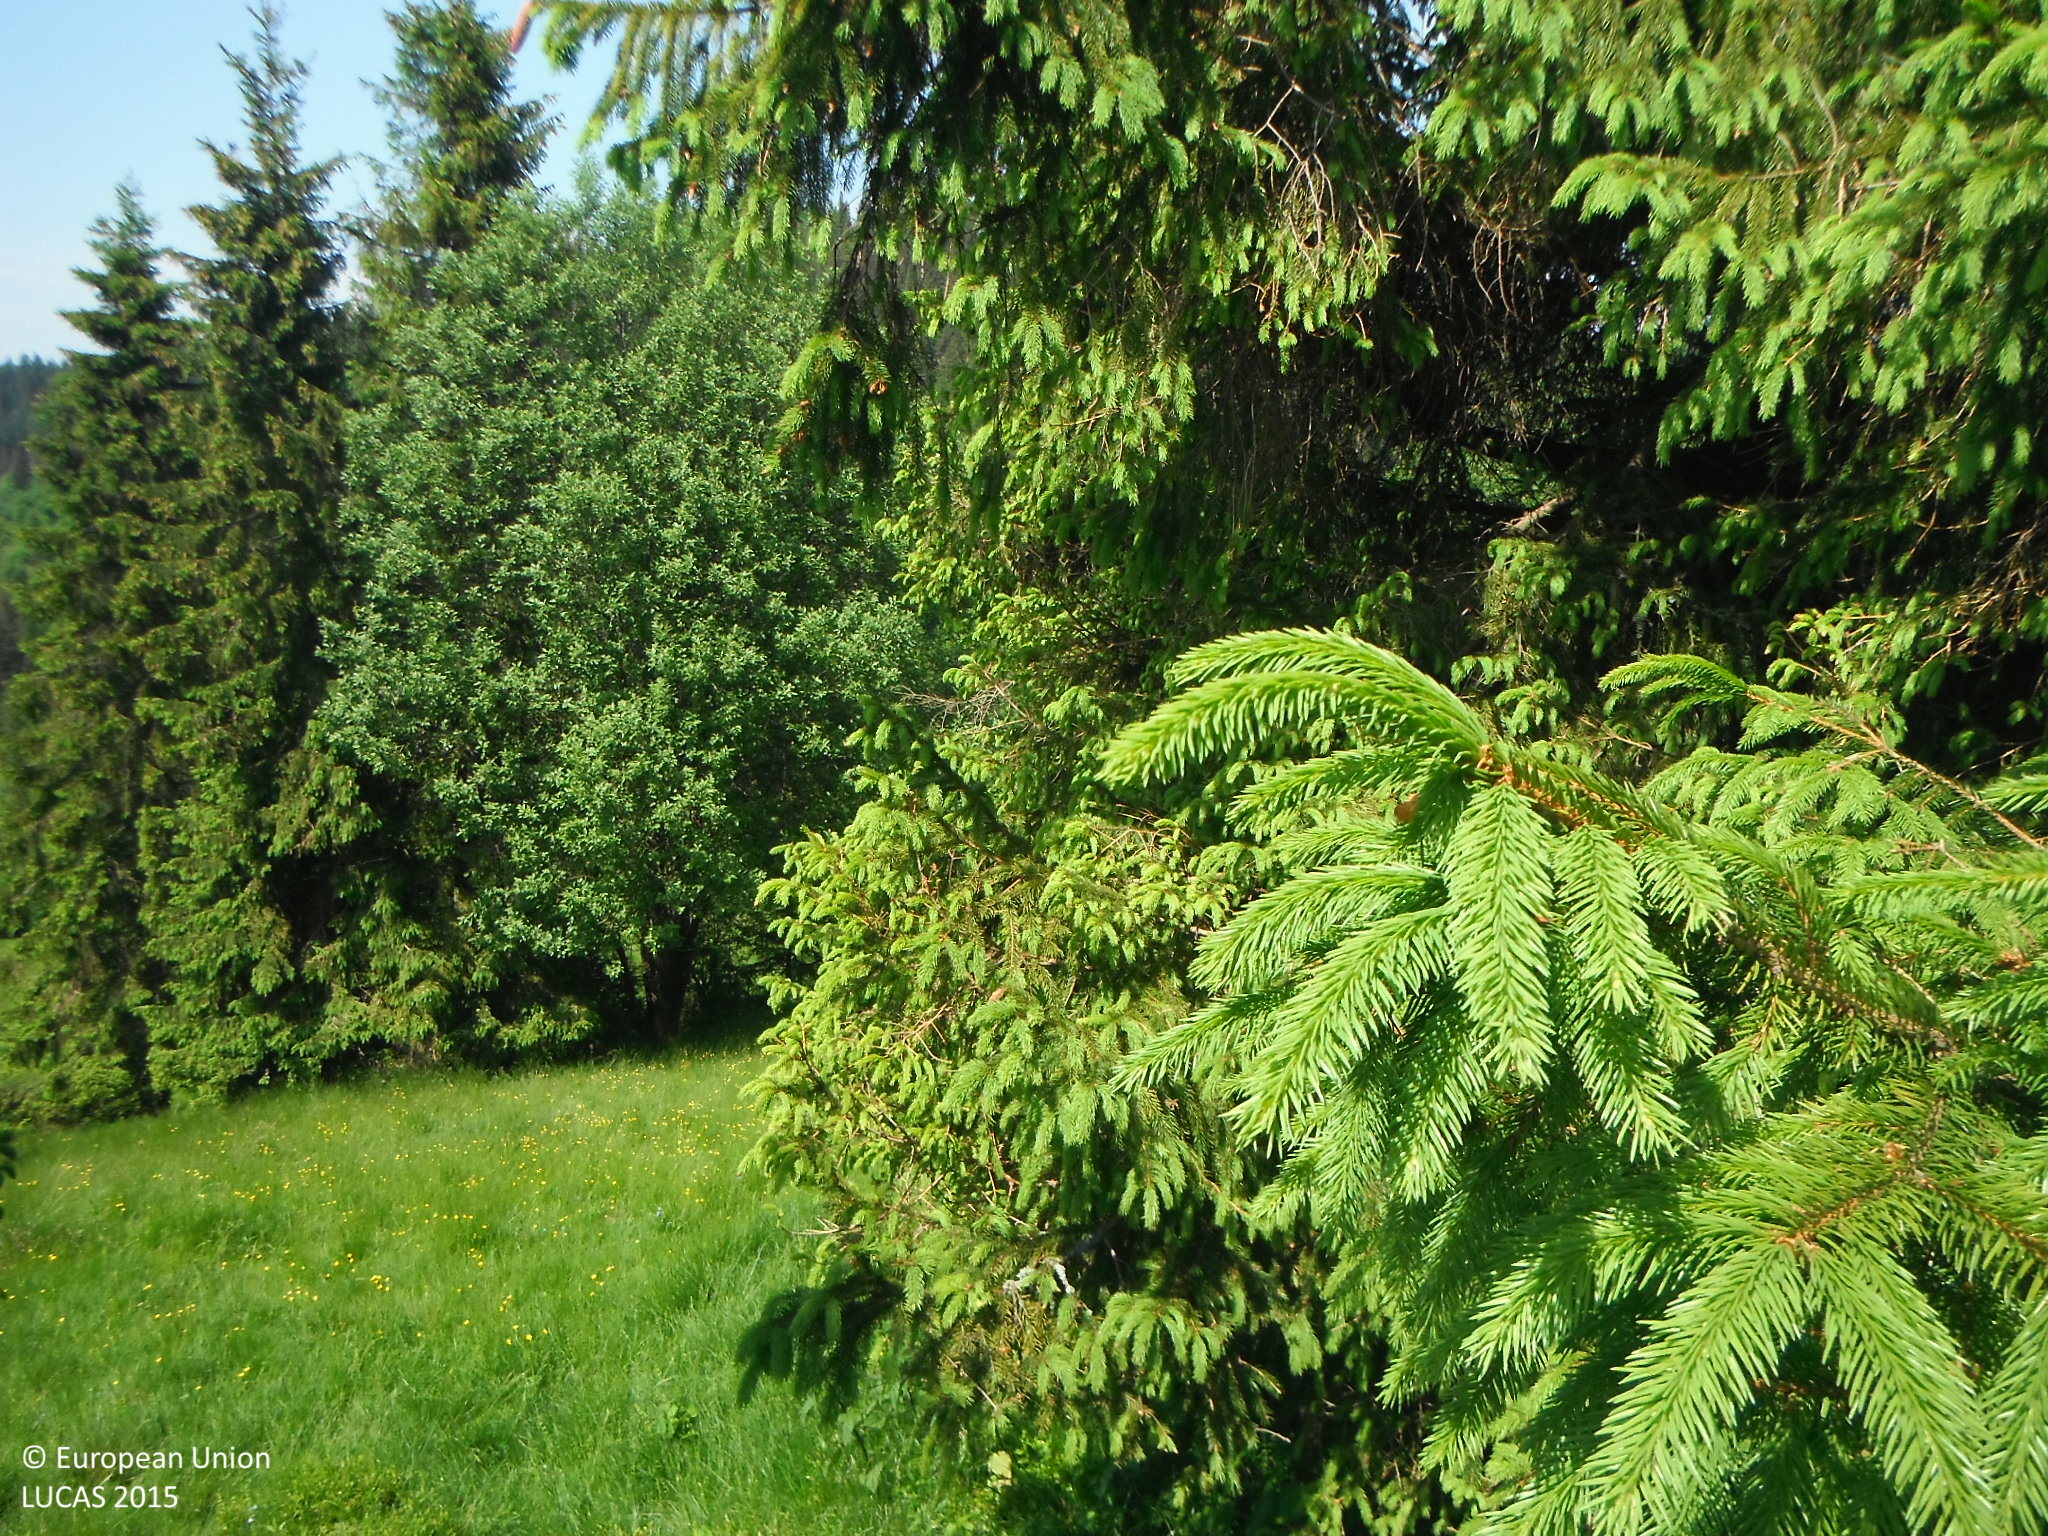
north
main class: Woodland
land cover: Spruce dominated mixed woodland
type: hemiboreal forest and nemoral coniferous forest and mixed broadleaved-coniferous forest
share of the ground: 25 - 50 %
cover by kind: herbaceous plants 60 %, coniferous forest trees 20 %, broadleaved forest trees 20 %
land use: Agriculture (excluding fallow land and kitchen gardens)
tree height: > 5 m
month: June
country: SK
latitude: 49.2887
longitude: 20.4159
